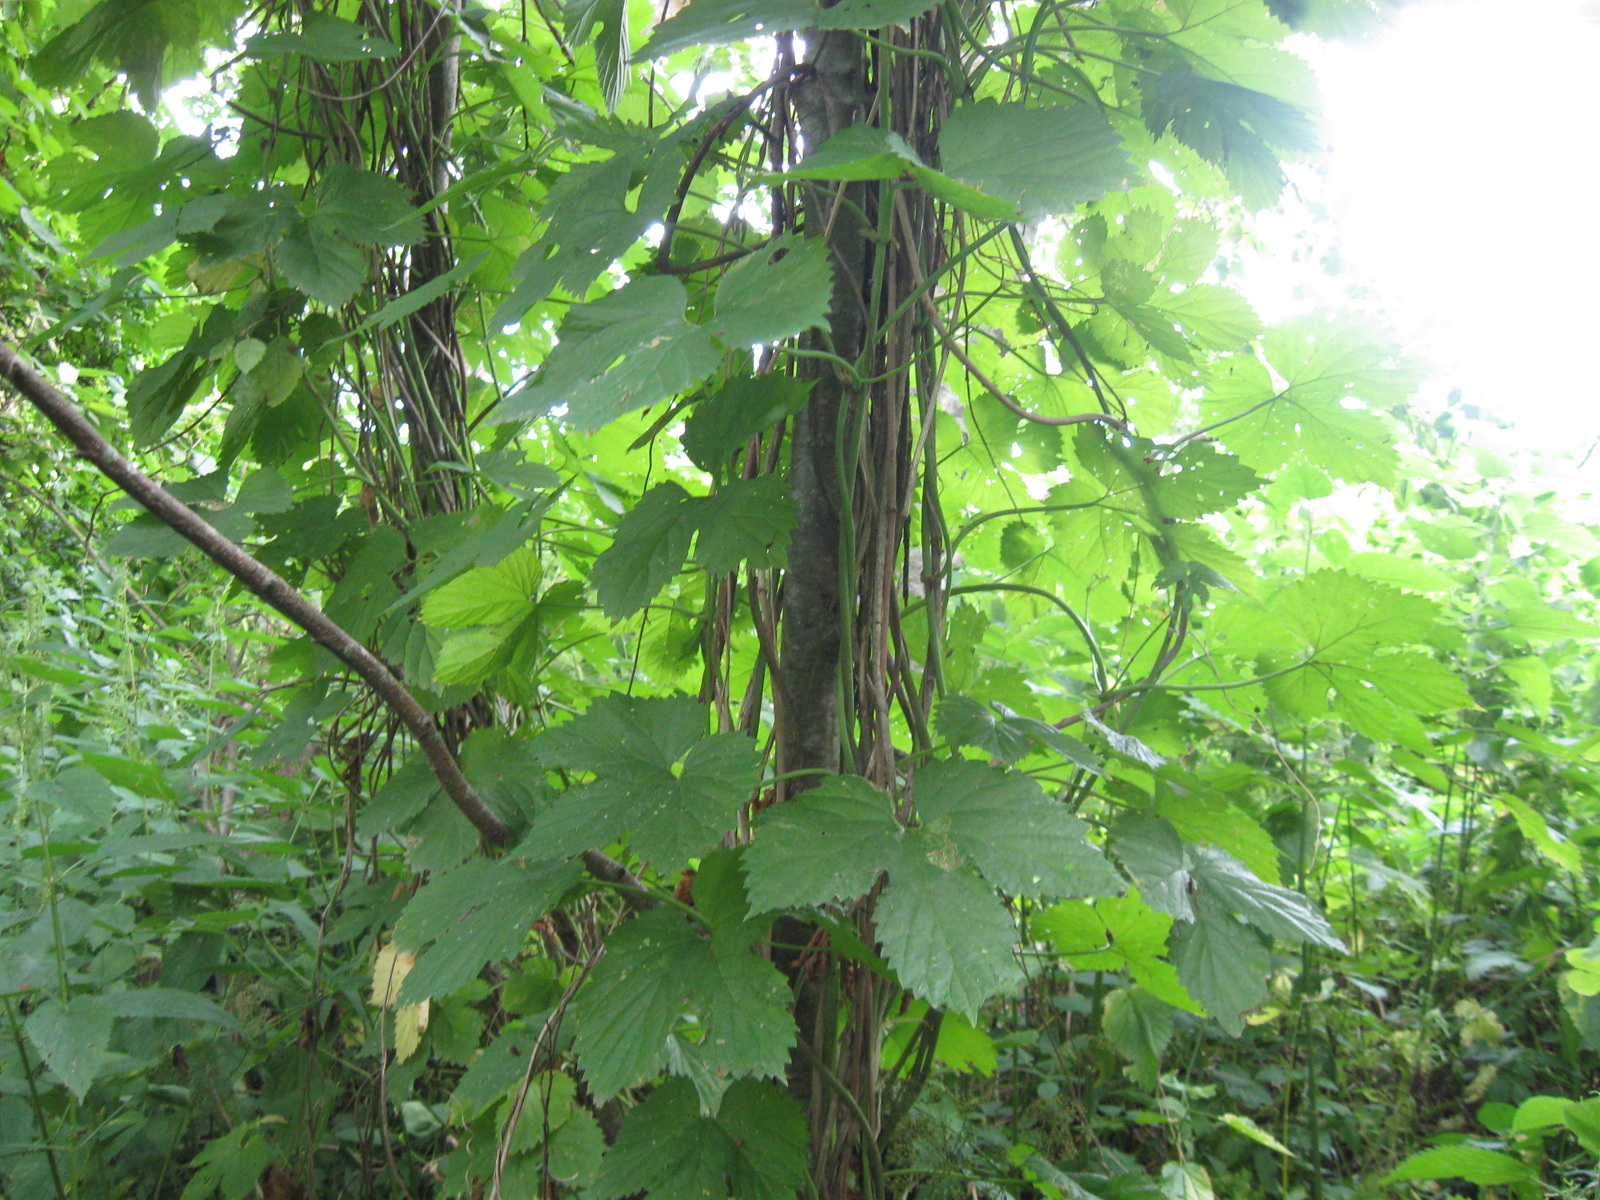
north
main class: Woodland
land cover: Broadleaved woodland
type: floodplain forest
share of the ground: > 75 %
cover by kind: broadleaved forest trees 90 %, herbaceous plants 10 %
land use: Forestry
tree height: > 5 m
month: July
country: LT
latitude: 54.9634
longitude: 23.6246
